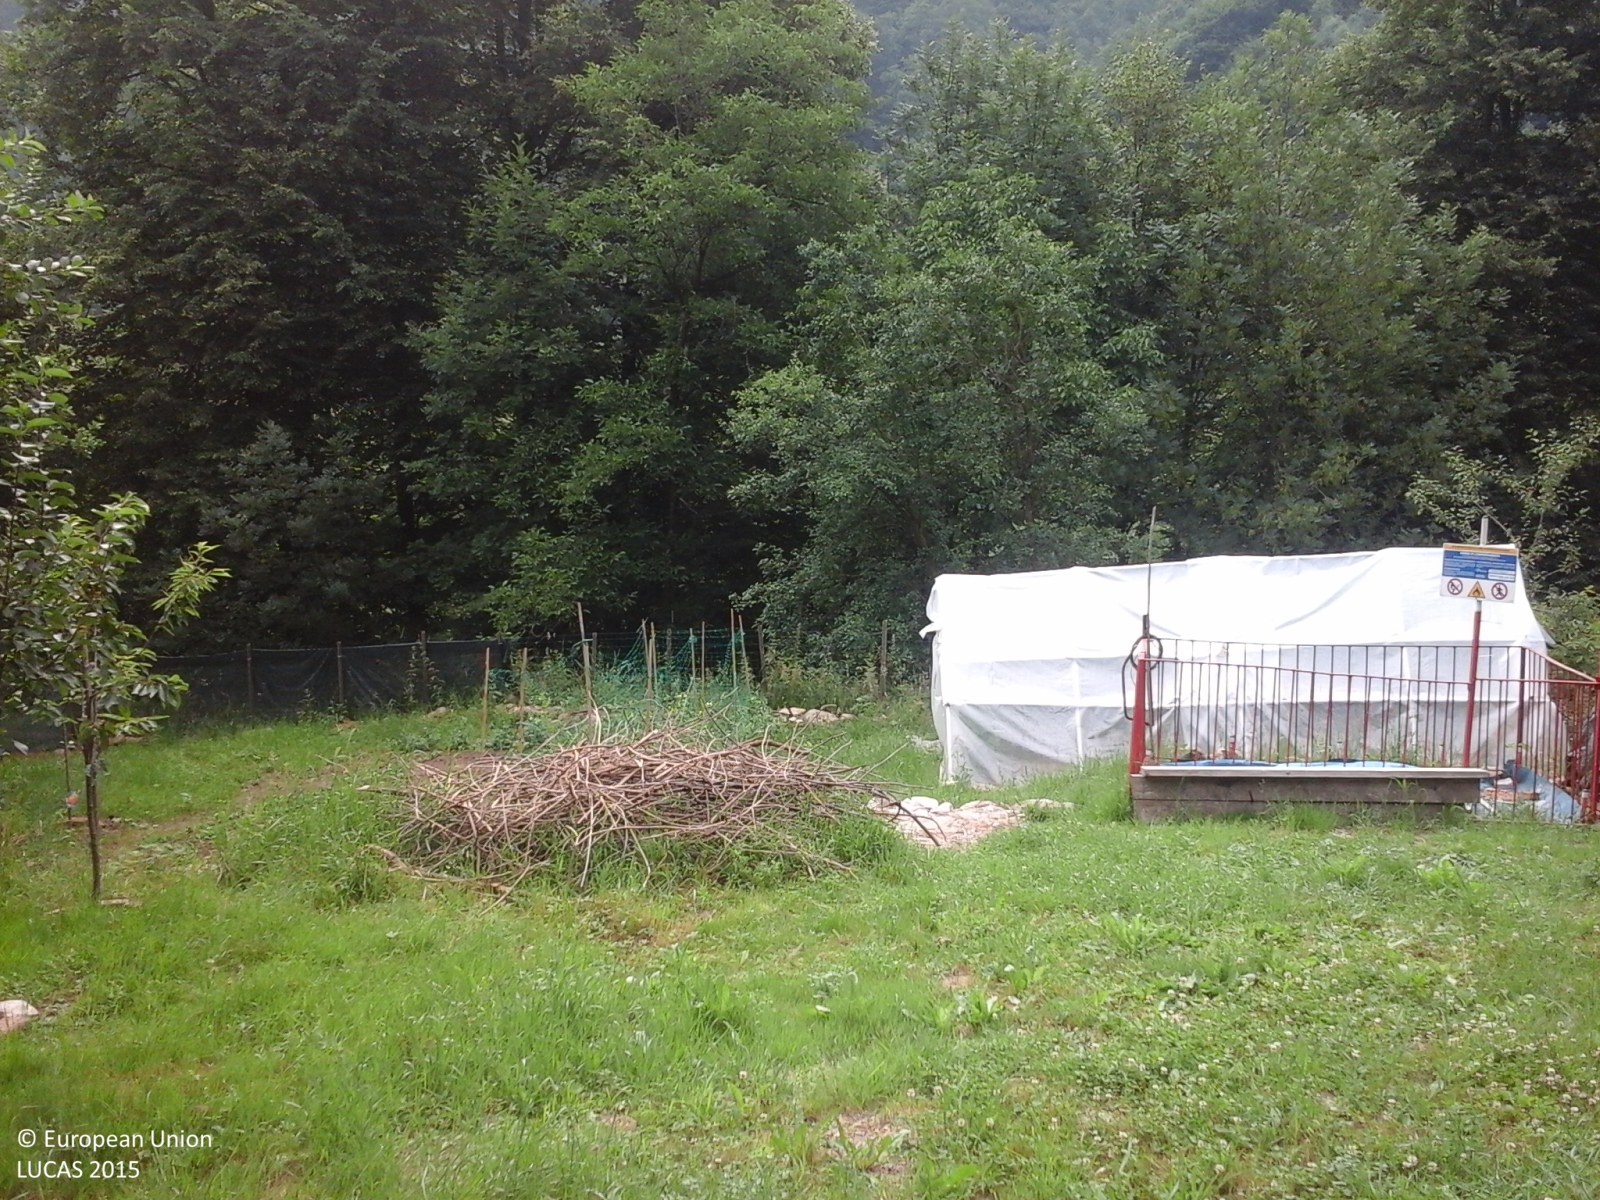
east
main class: Woodland
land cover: Broadleaved woodland
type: mesophytic deciduous forest
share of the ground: > 75 %
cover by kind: broadleaved forest trees 100 %
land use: Forestry
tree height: > 5 m
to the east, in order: Broadleaved woodland; Tracks; Broadleaved woodland
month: July
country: IT
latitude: 45.0358
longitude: 7.2501
